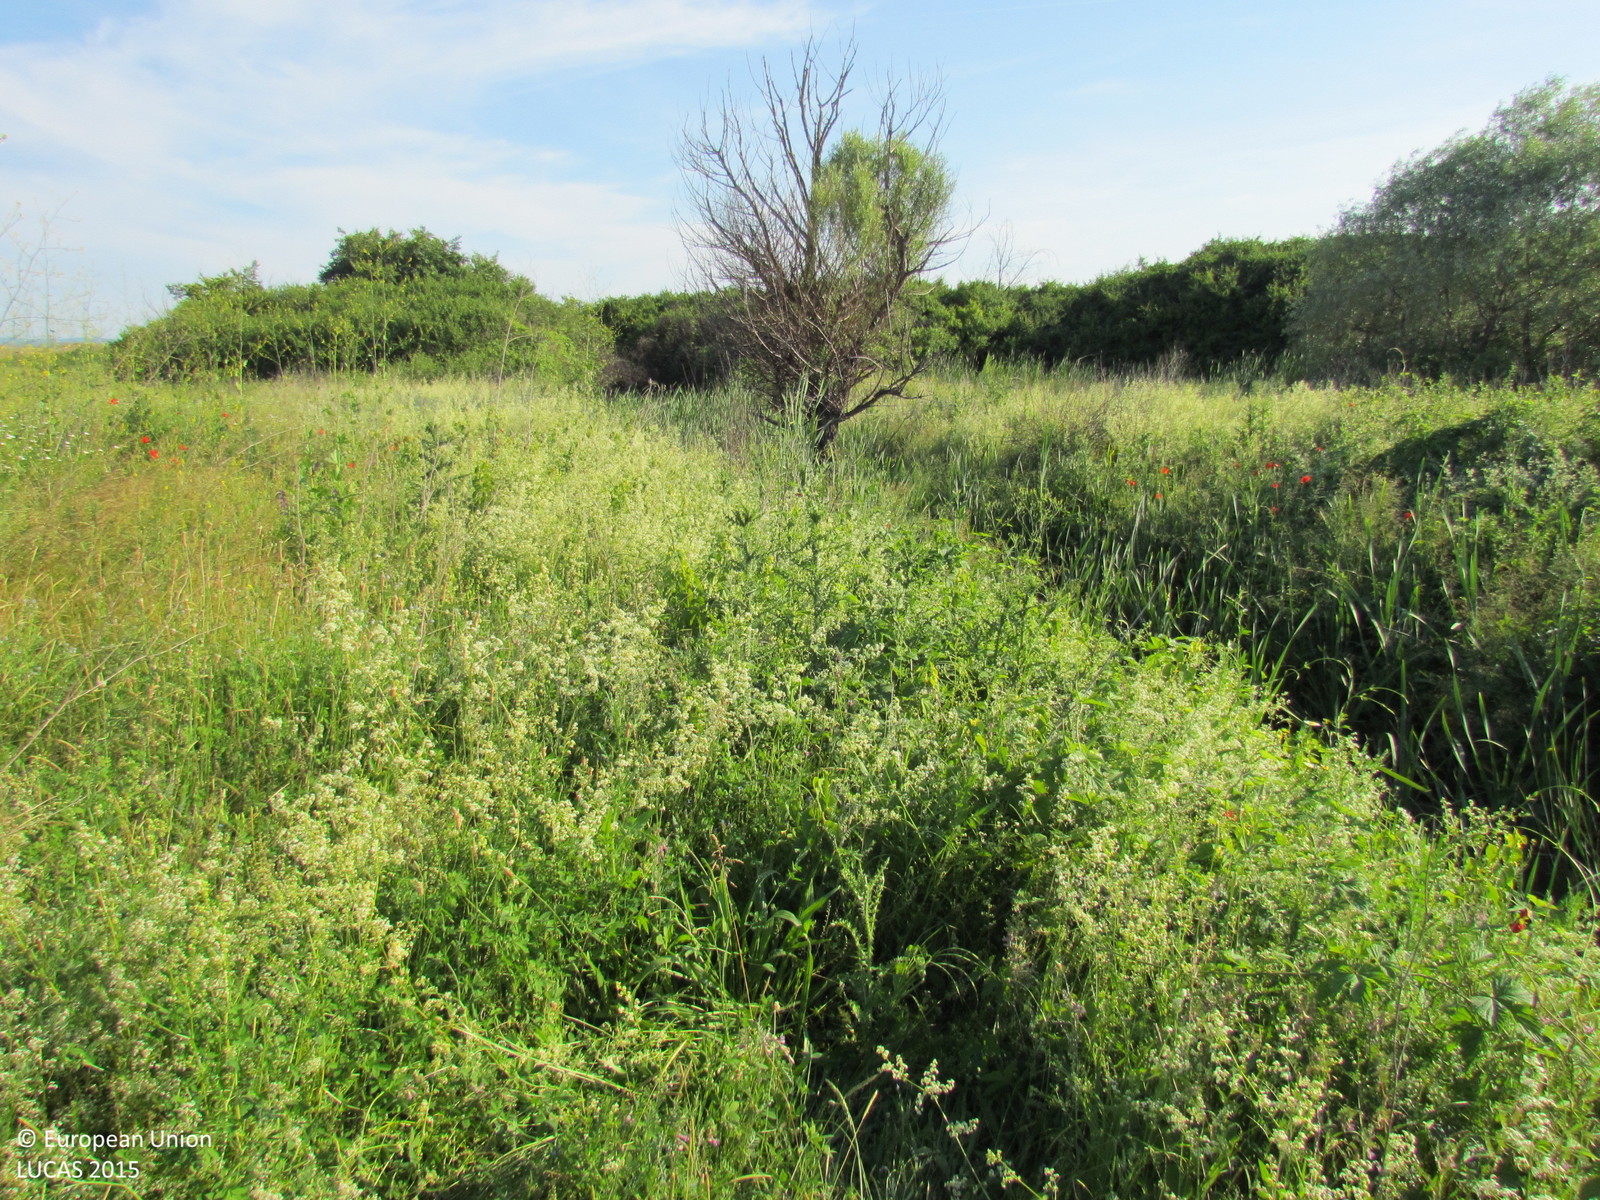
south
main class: Shrubland
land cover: Shrubland with sparse tree cover
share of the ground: > 75 %
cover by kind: herbaceous plants 60 %, shrubs 35 %, broadleaved forest trees 5 %
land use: Semi-natural and natural areas not in use
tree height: < 5 m
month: June
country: BG
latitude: 42.4951
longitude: 27.2053
